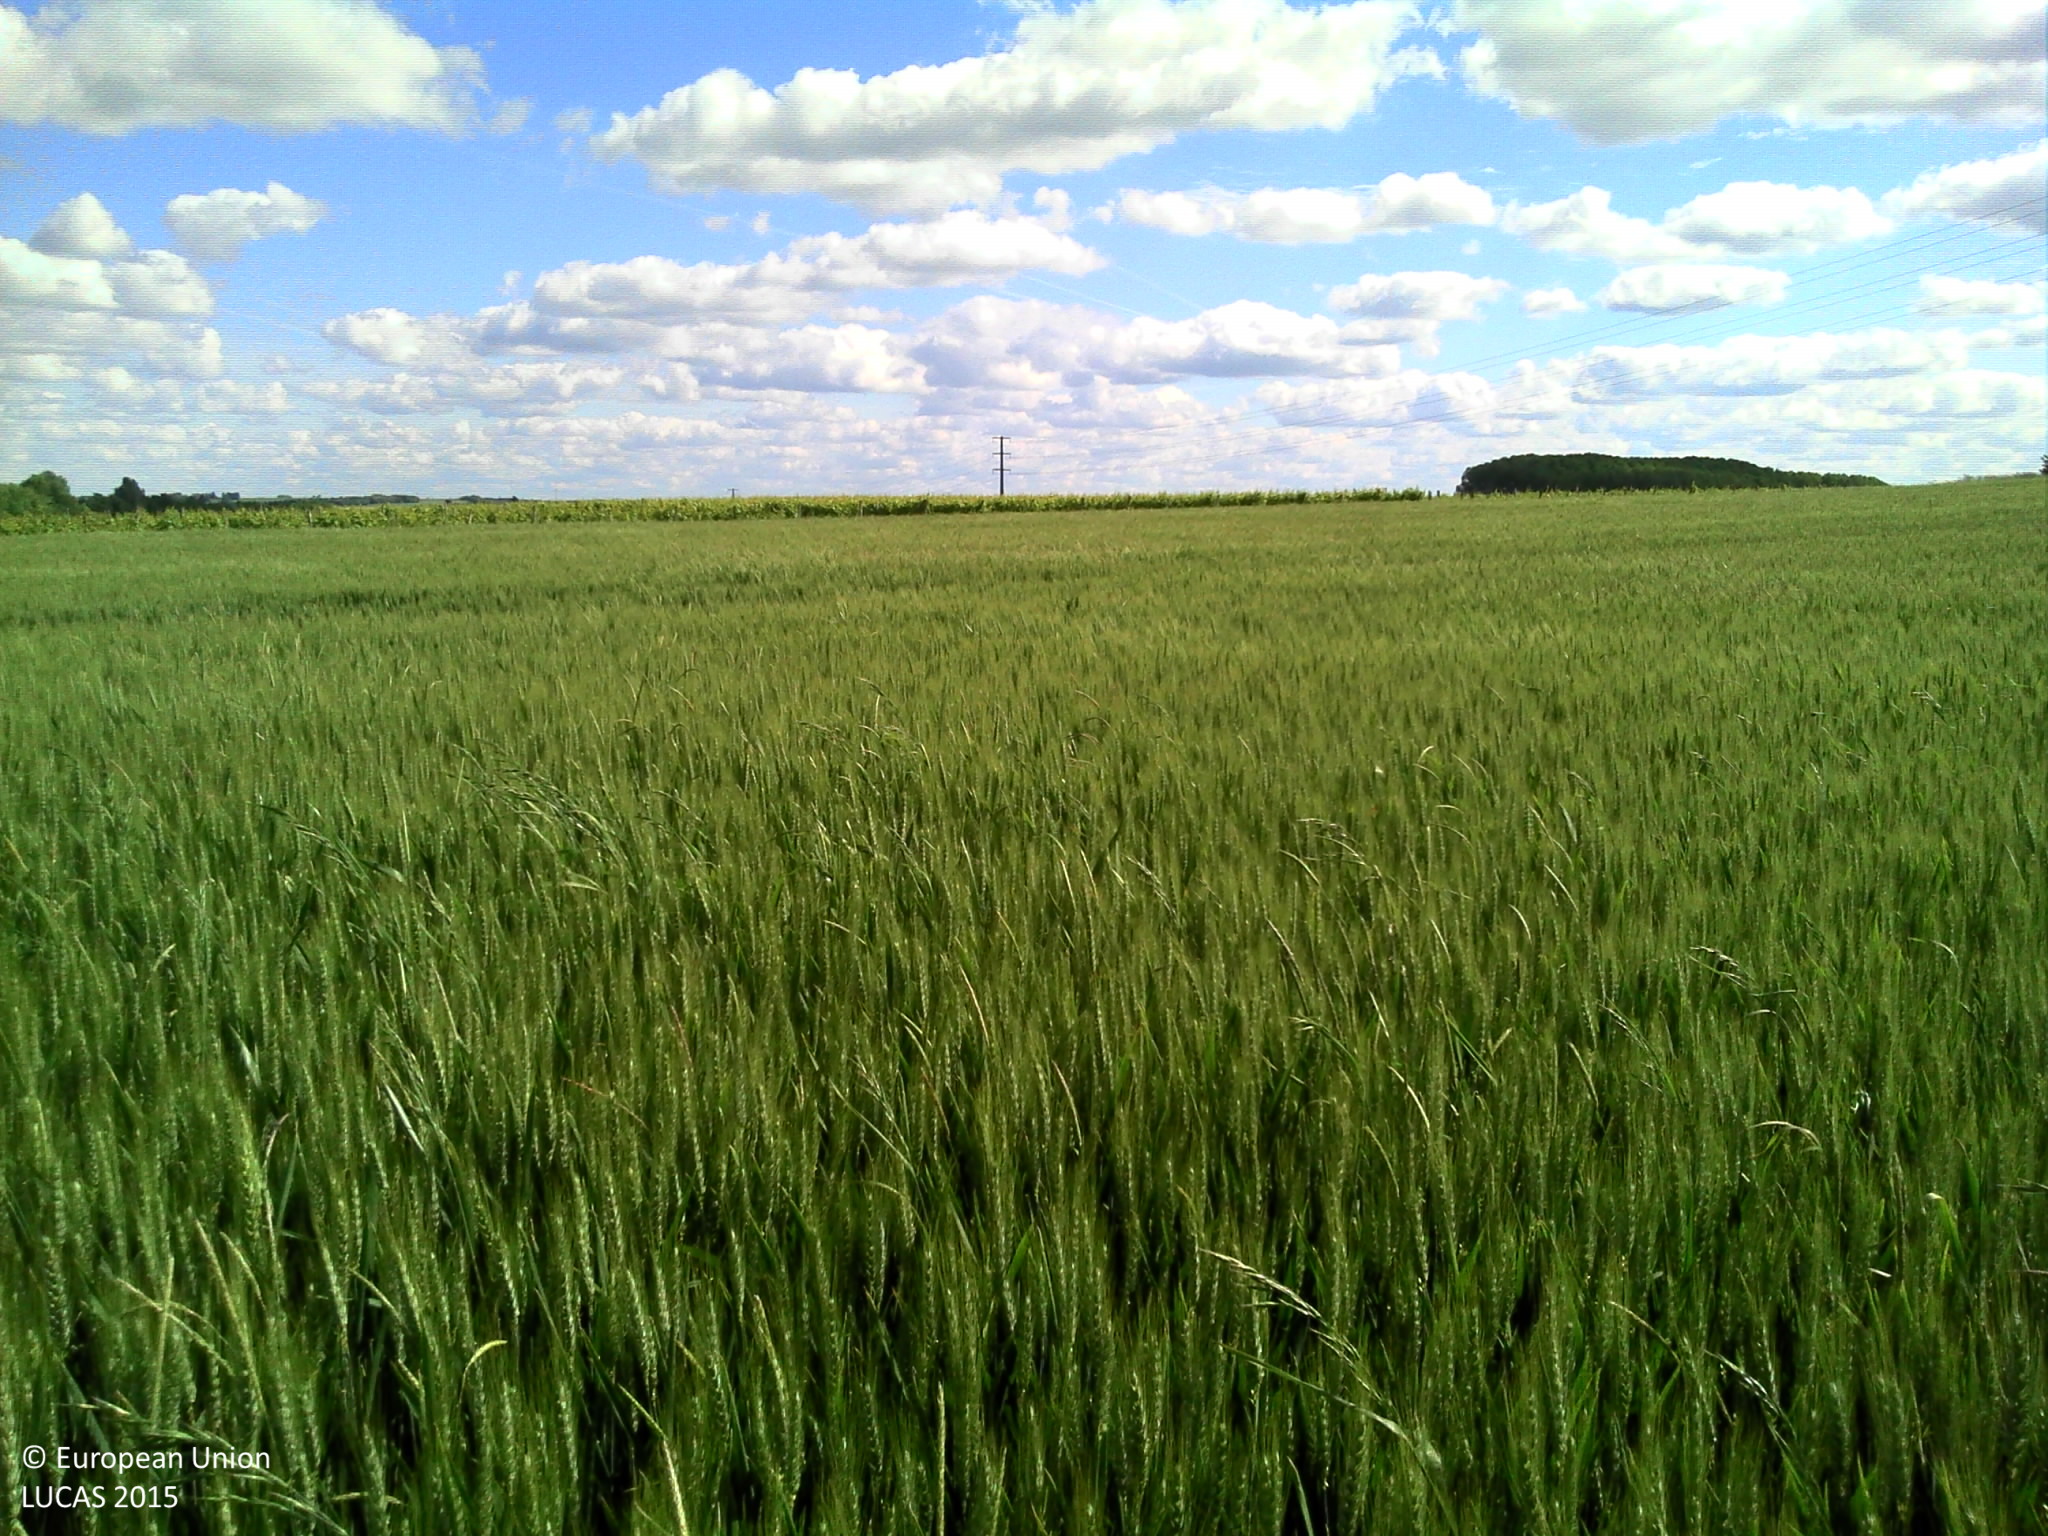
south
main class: Cropland
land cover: Common wheat
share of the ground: > 75 %
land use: Agriculture (excluding fallow land and kitchen gardens)
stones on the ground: < 10 %
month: May
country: FR
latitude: 46.7704
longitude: 0.1967
